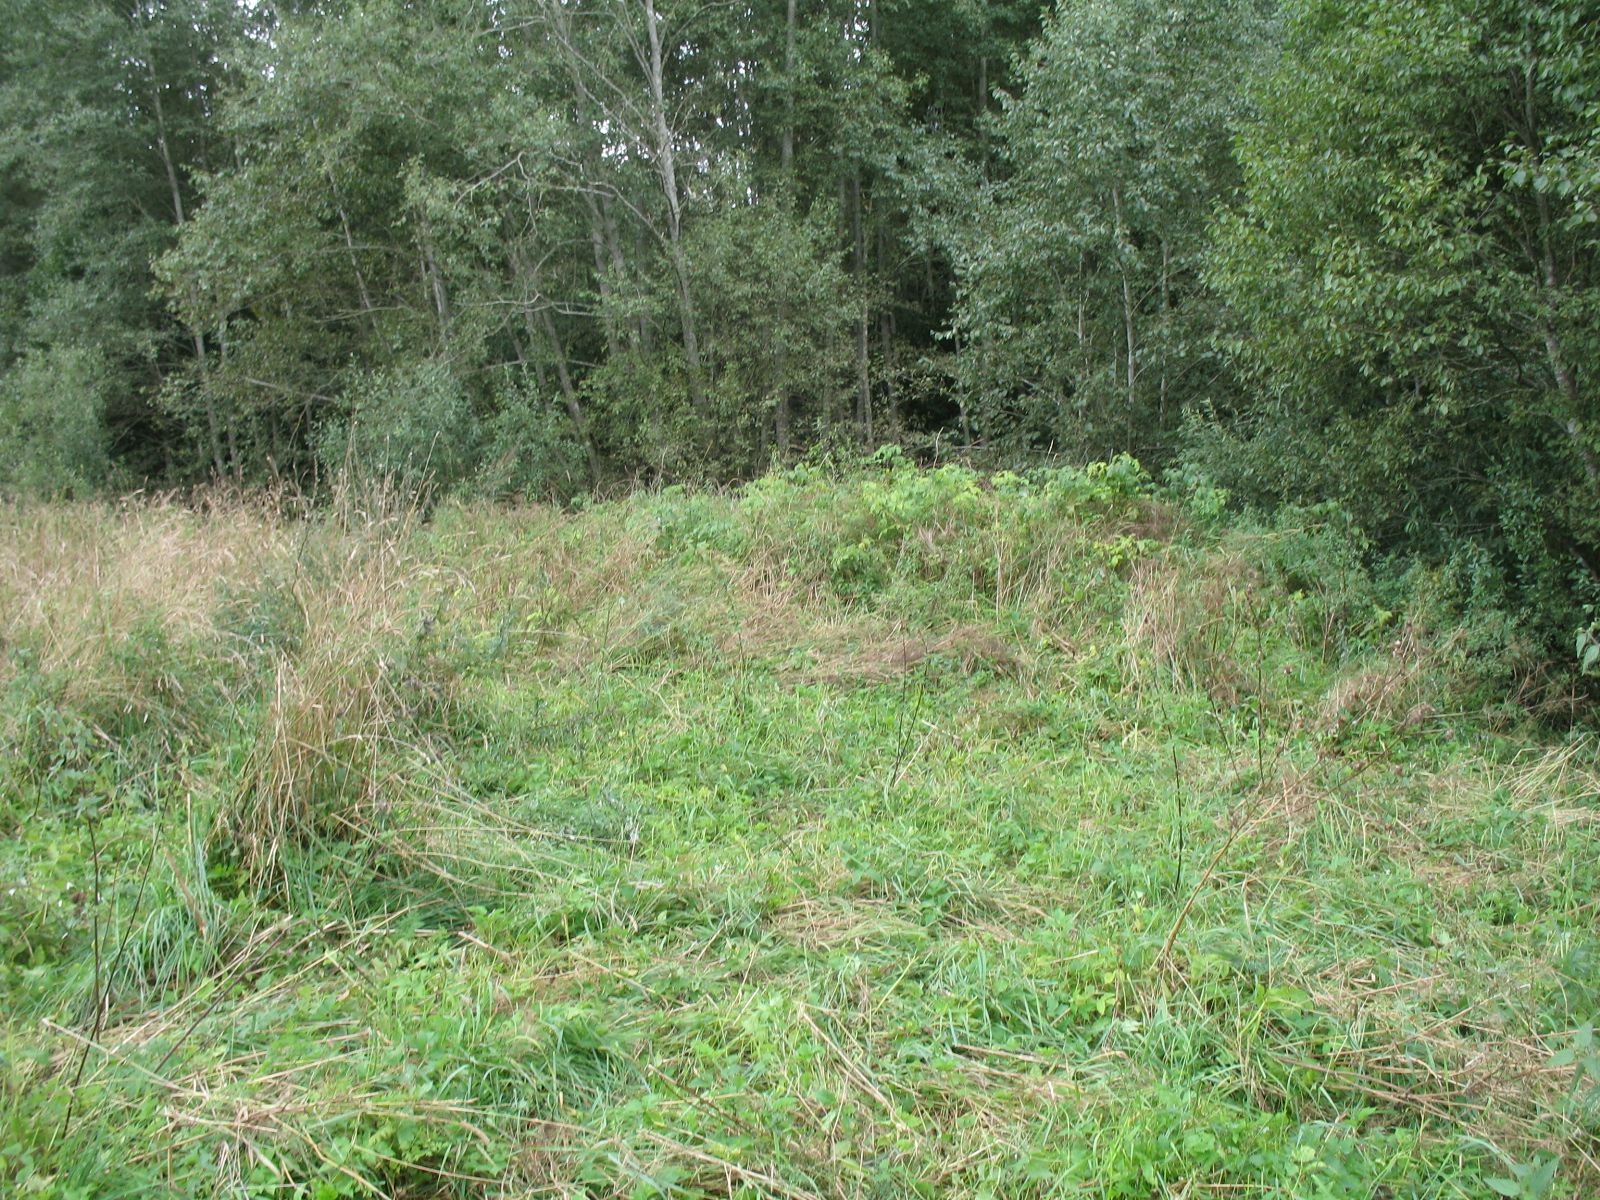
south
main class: Grassland
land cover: Grassland without tree/shrub cover
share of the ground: > 75 %
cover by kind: herbaceous plants 100 %
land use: Agriculture (excluding fallow land and kitchen gardens)
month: September
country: LV
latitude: 56.1182
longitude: 25.9443
